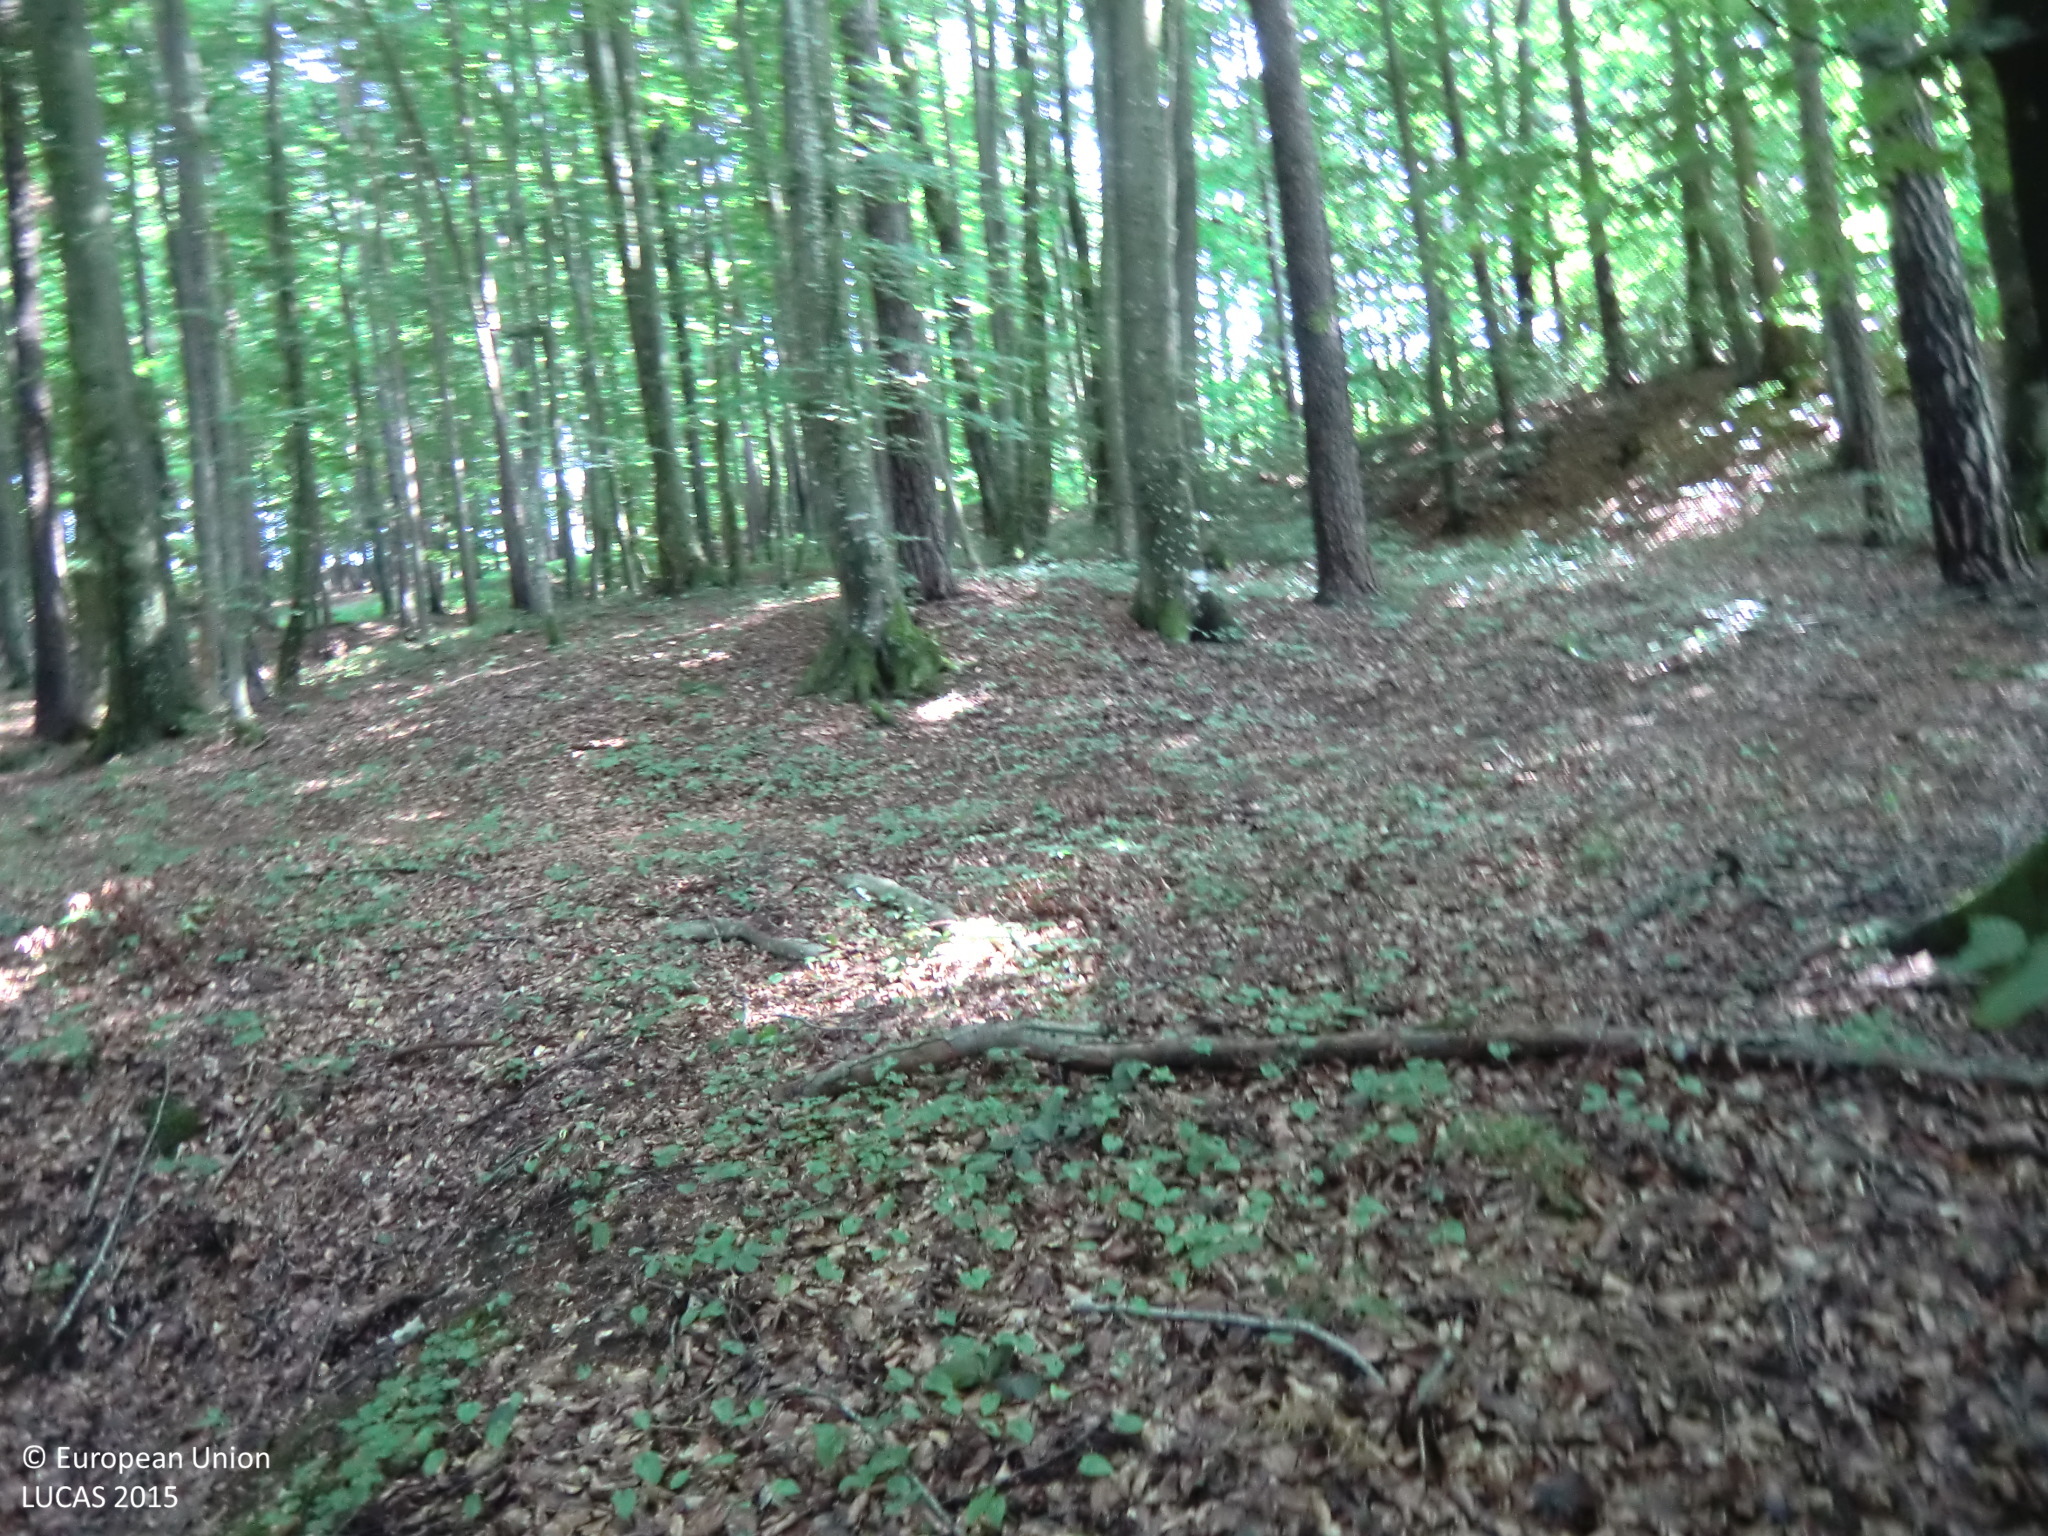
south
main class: Woodland
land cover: Pine dominated mixed woodland
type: hemiboreal forest and nemoral coniferous forest and mixed broadleaved-coniferous forest
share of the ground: > 75 %
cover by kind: broadleaved forest trees 60 %, coniferous forest trees 25 %, unconsolidated bare surface 10 %, herbaceous plants 5 %
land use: Forestry
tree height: > 5 m
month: July
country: AT
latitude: 47.0283
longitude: 15.7241
